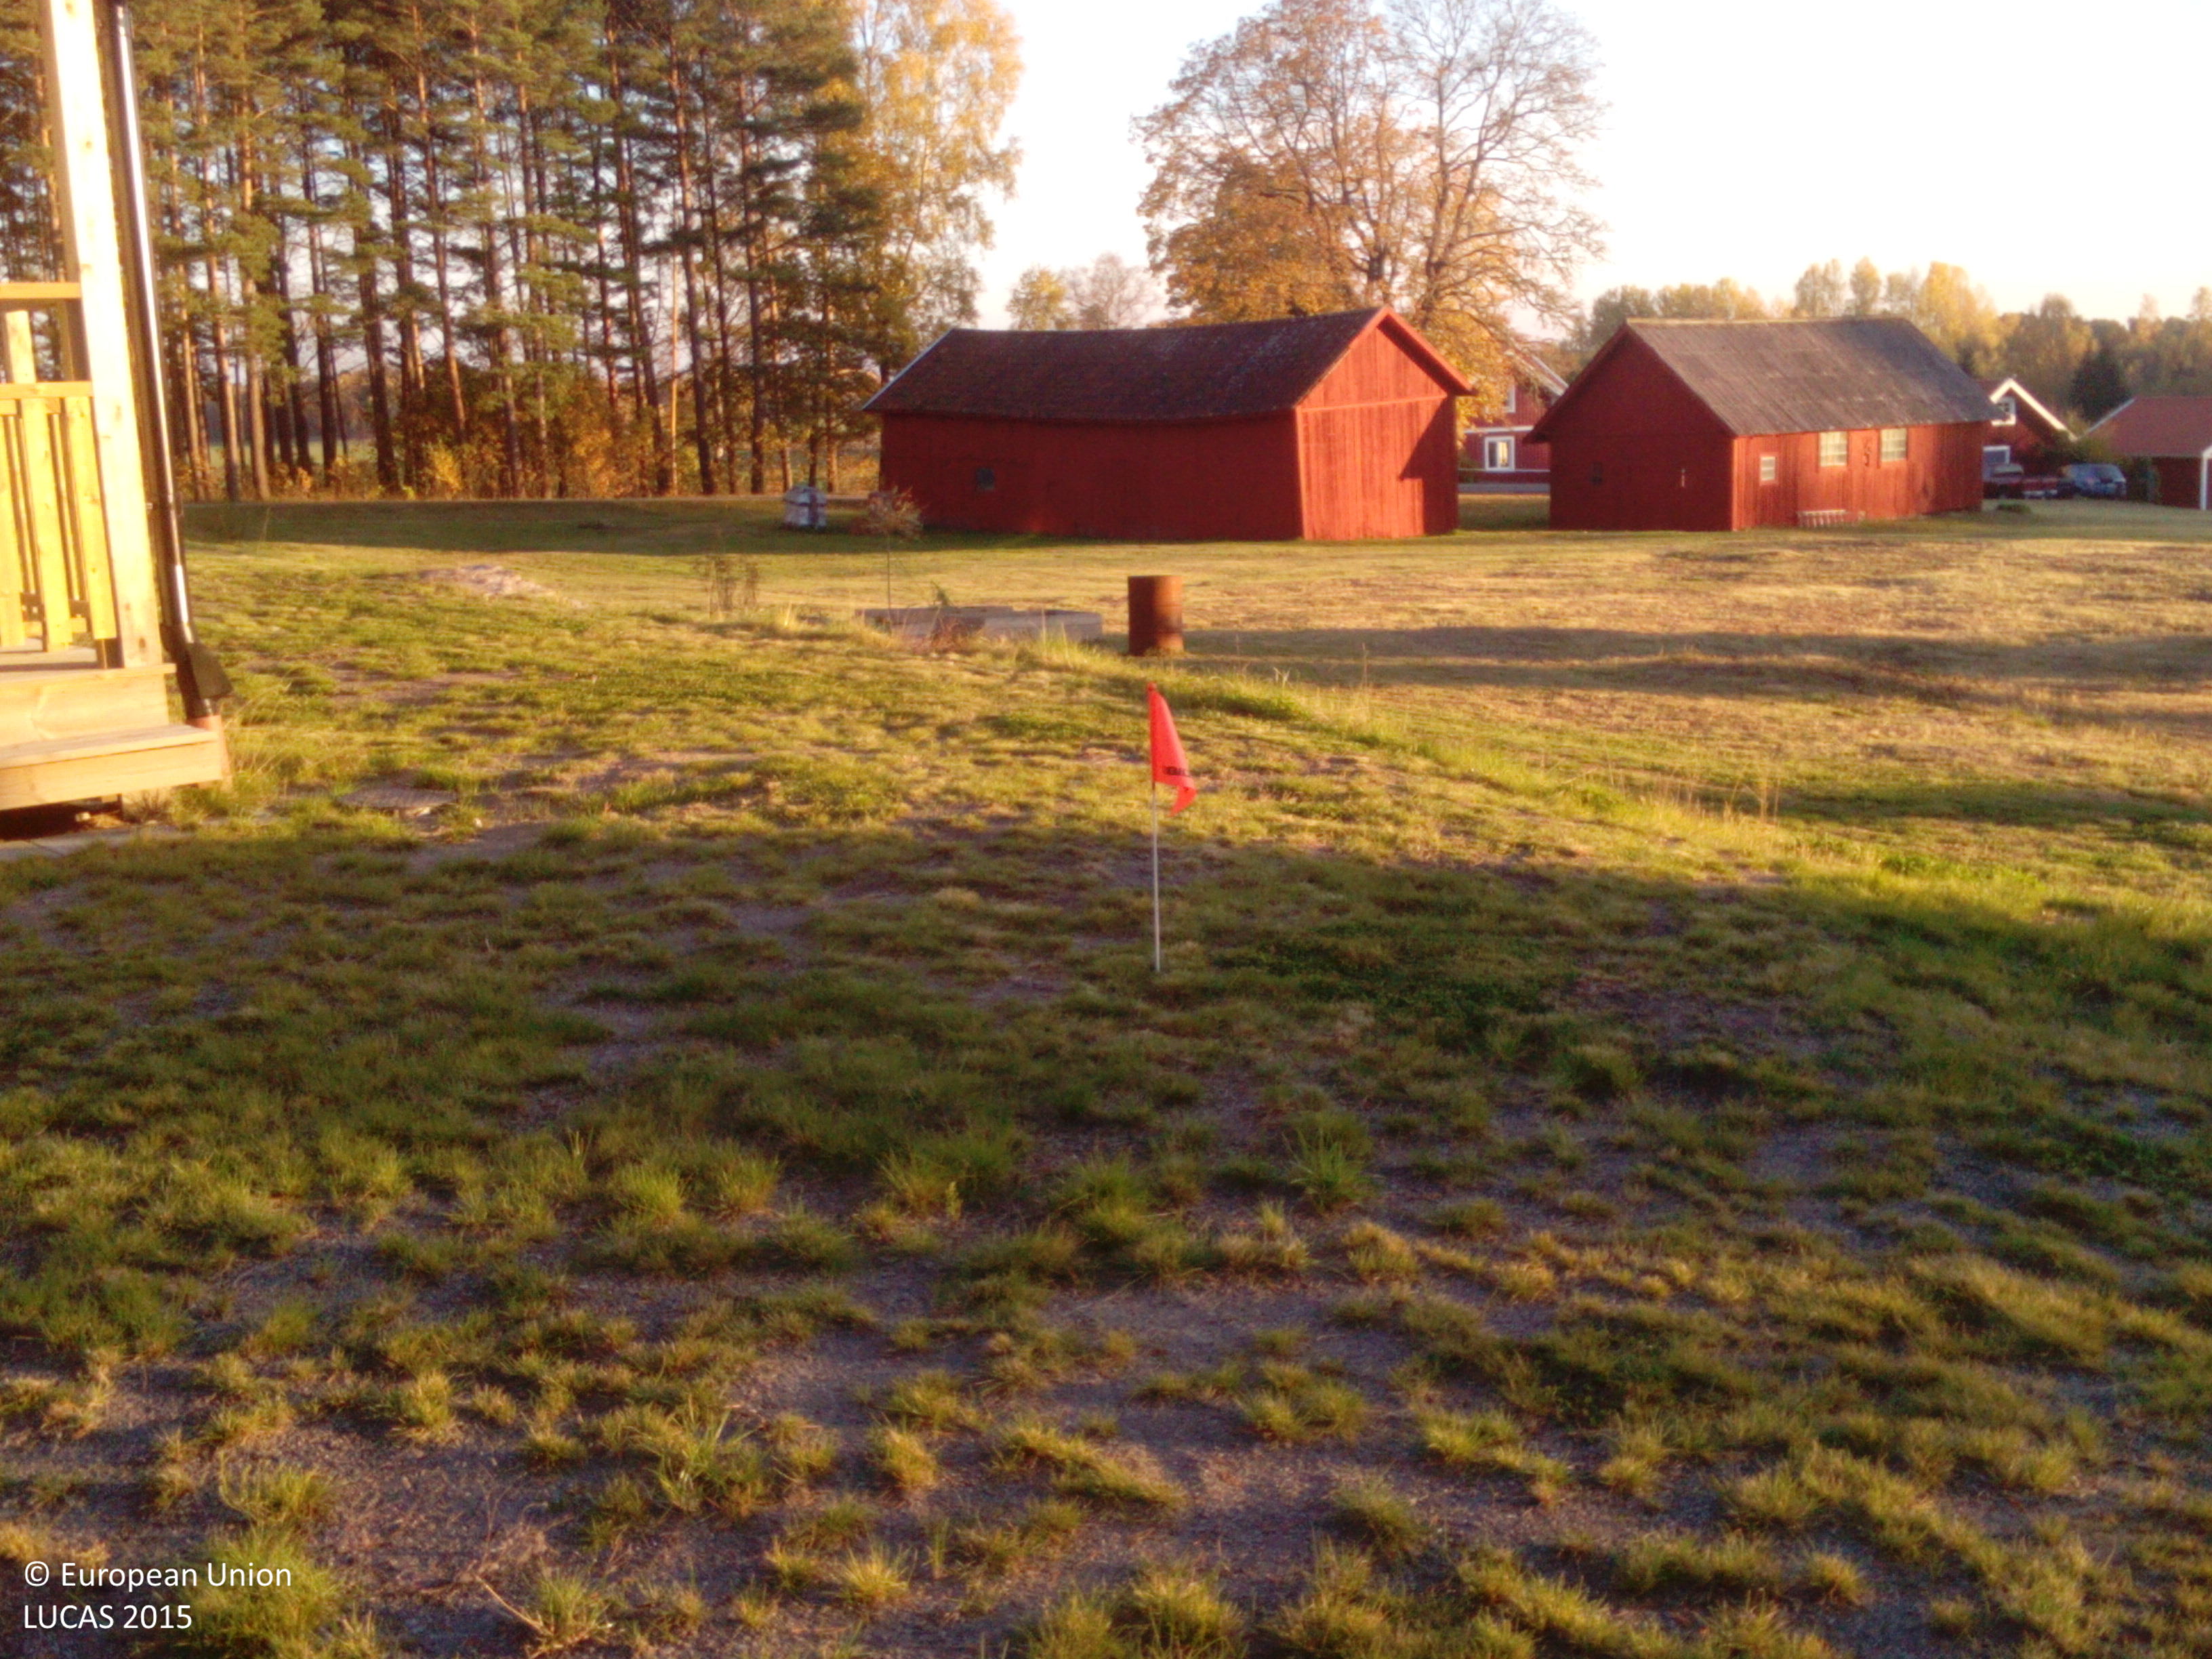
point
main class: Grassland
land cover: Grassland without tree/shrub cover
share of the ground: > 75 %
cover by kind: herbaceous plants 80 %
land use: Residential
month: October
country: SE
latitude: 58.8060
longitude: 16.7987
